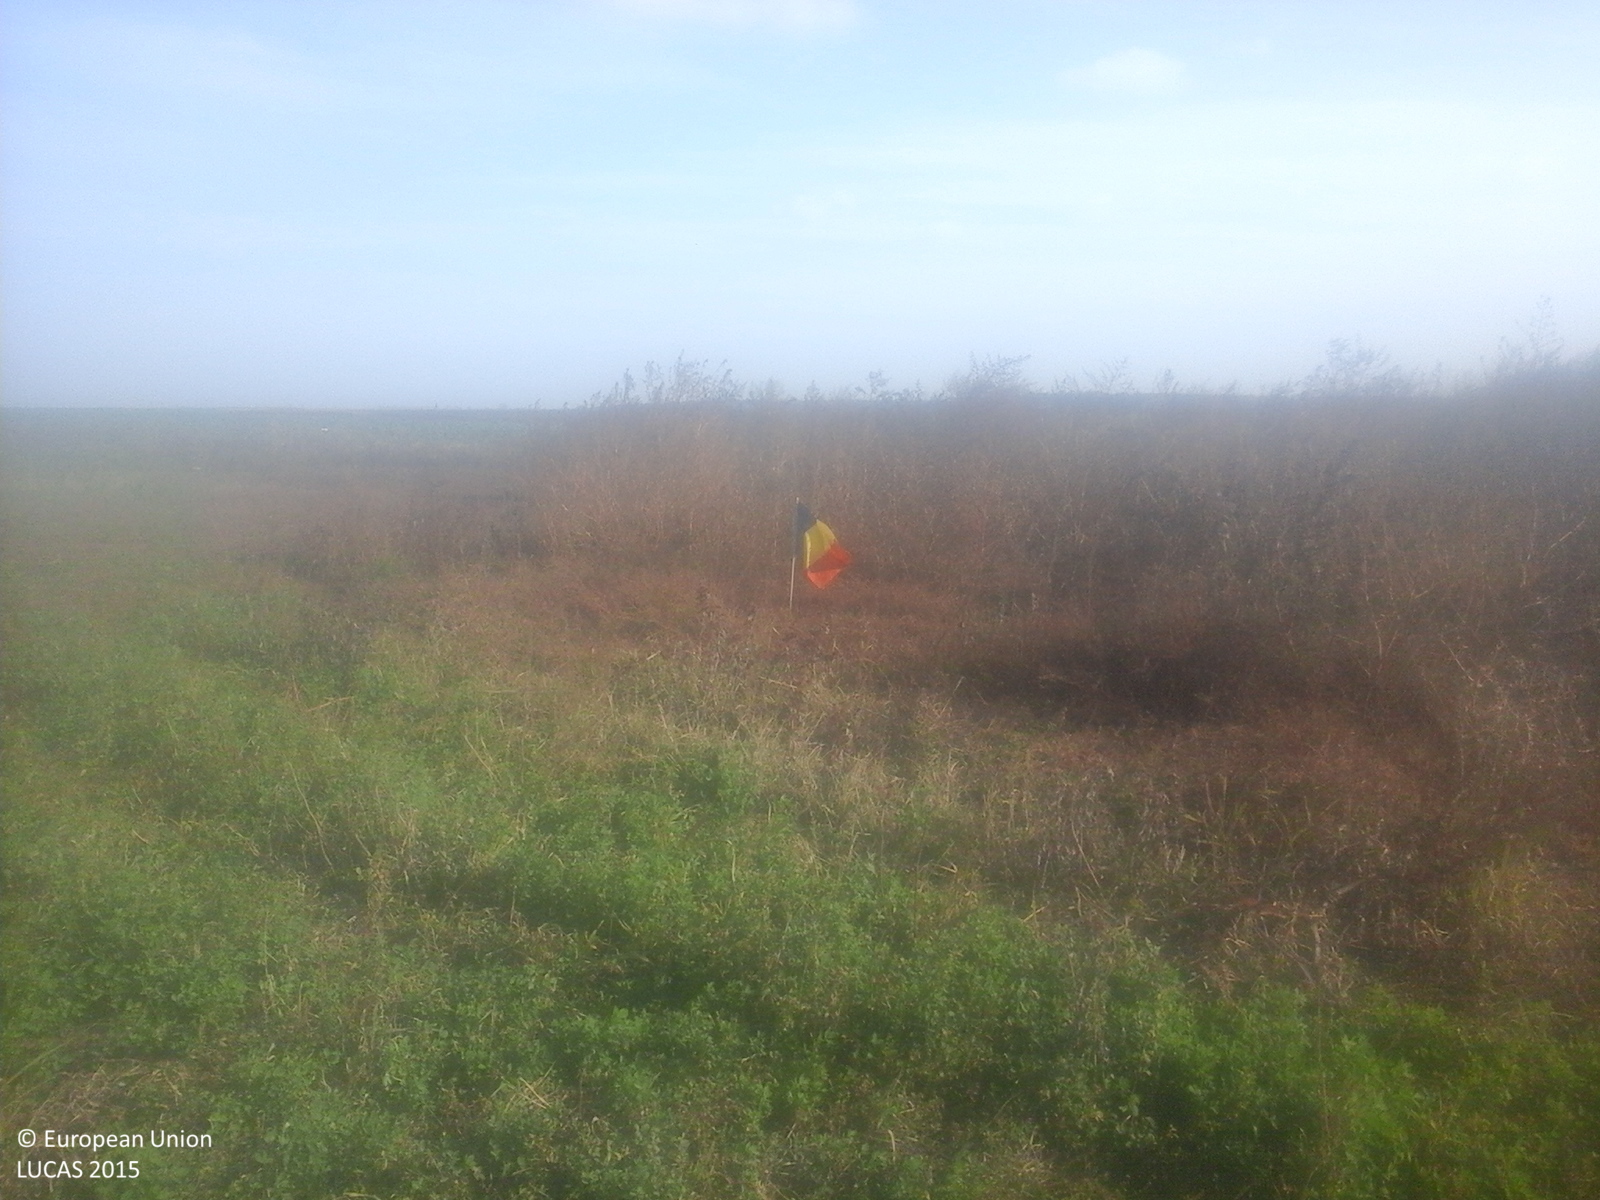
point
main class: Grassland
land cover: Spontaneously vegetated surfaces
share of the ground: > 75 %
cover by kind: herbaceous plants 100 %
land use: Agriculture (excluding fallow land and kitchen gardens)
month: October
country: RO
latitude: 45.4034
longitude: 27.0943
